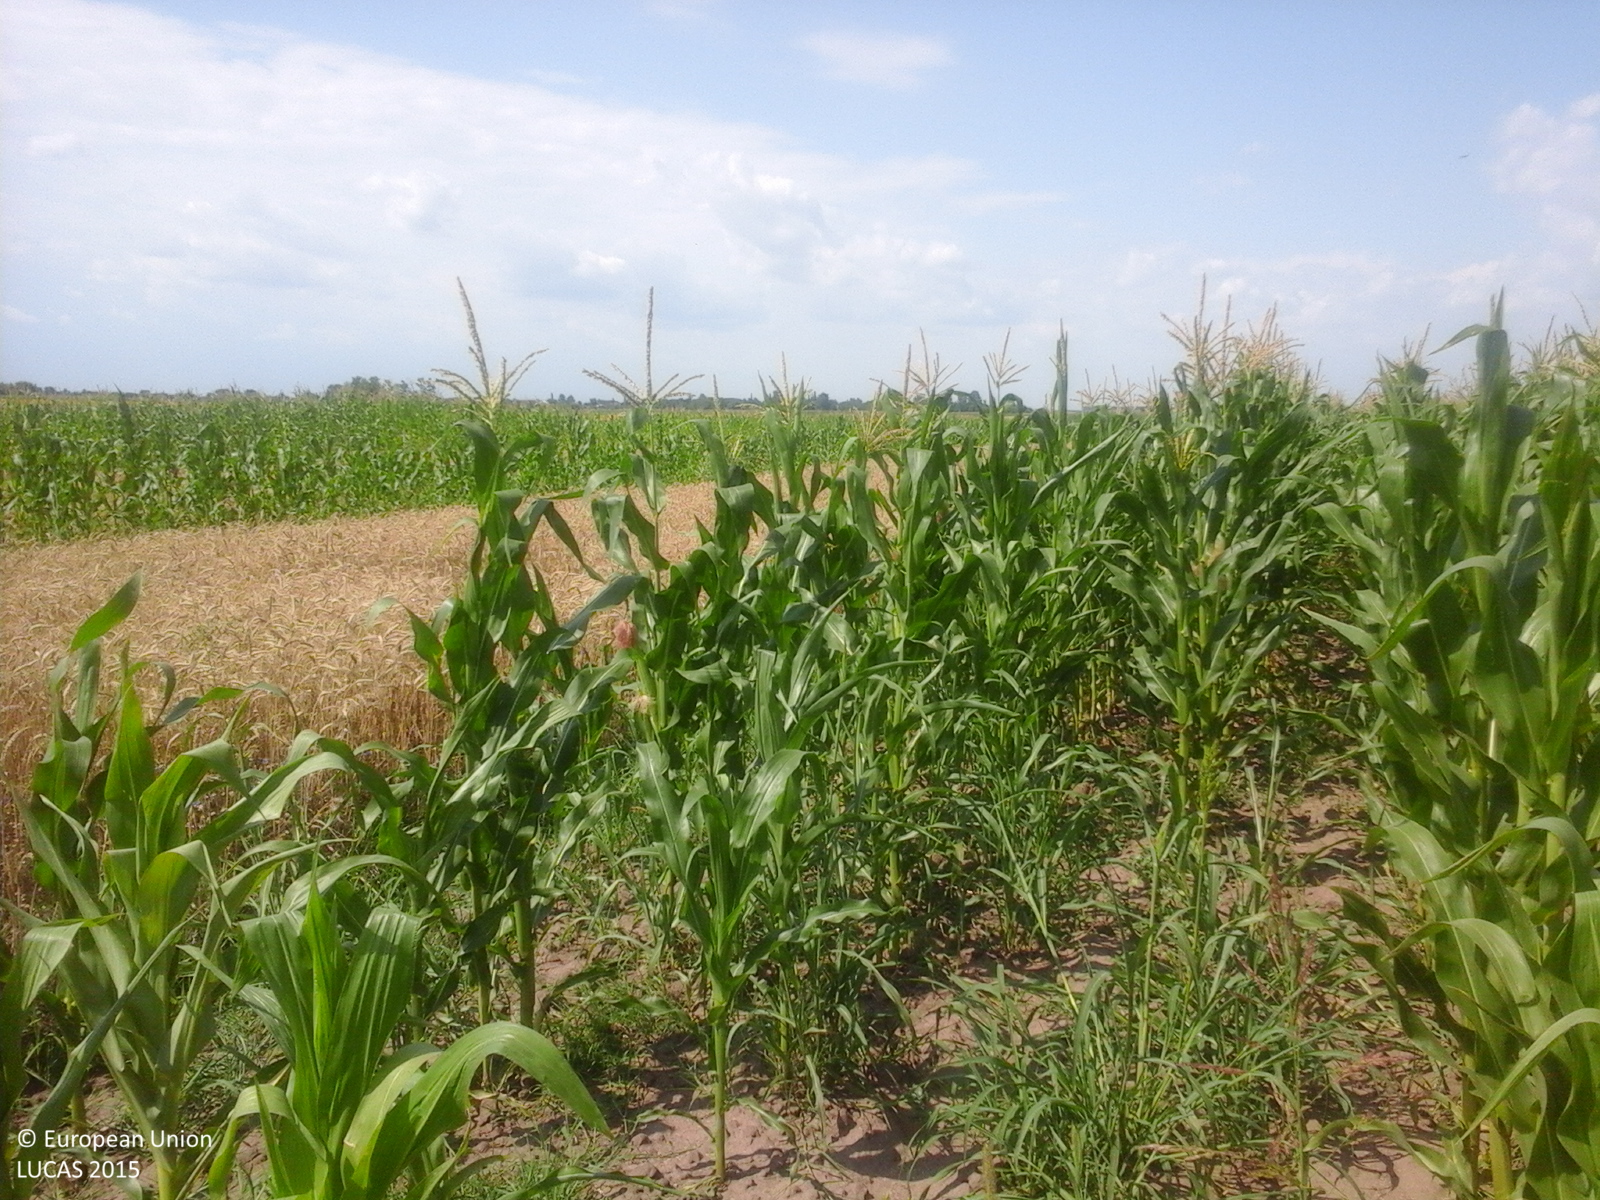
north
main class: Cropland
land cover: Maize
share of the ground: > 75 %
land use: Agriculture (excluding fallow land and kitchen gardens)
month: July
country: RO
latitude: 43.9741
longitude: 24.1838
